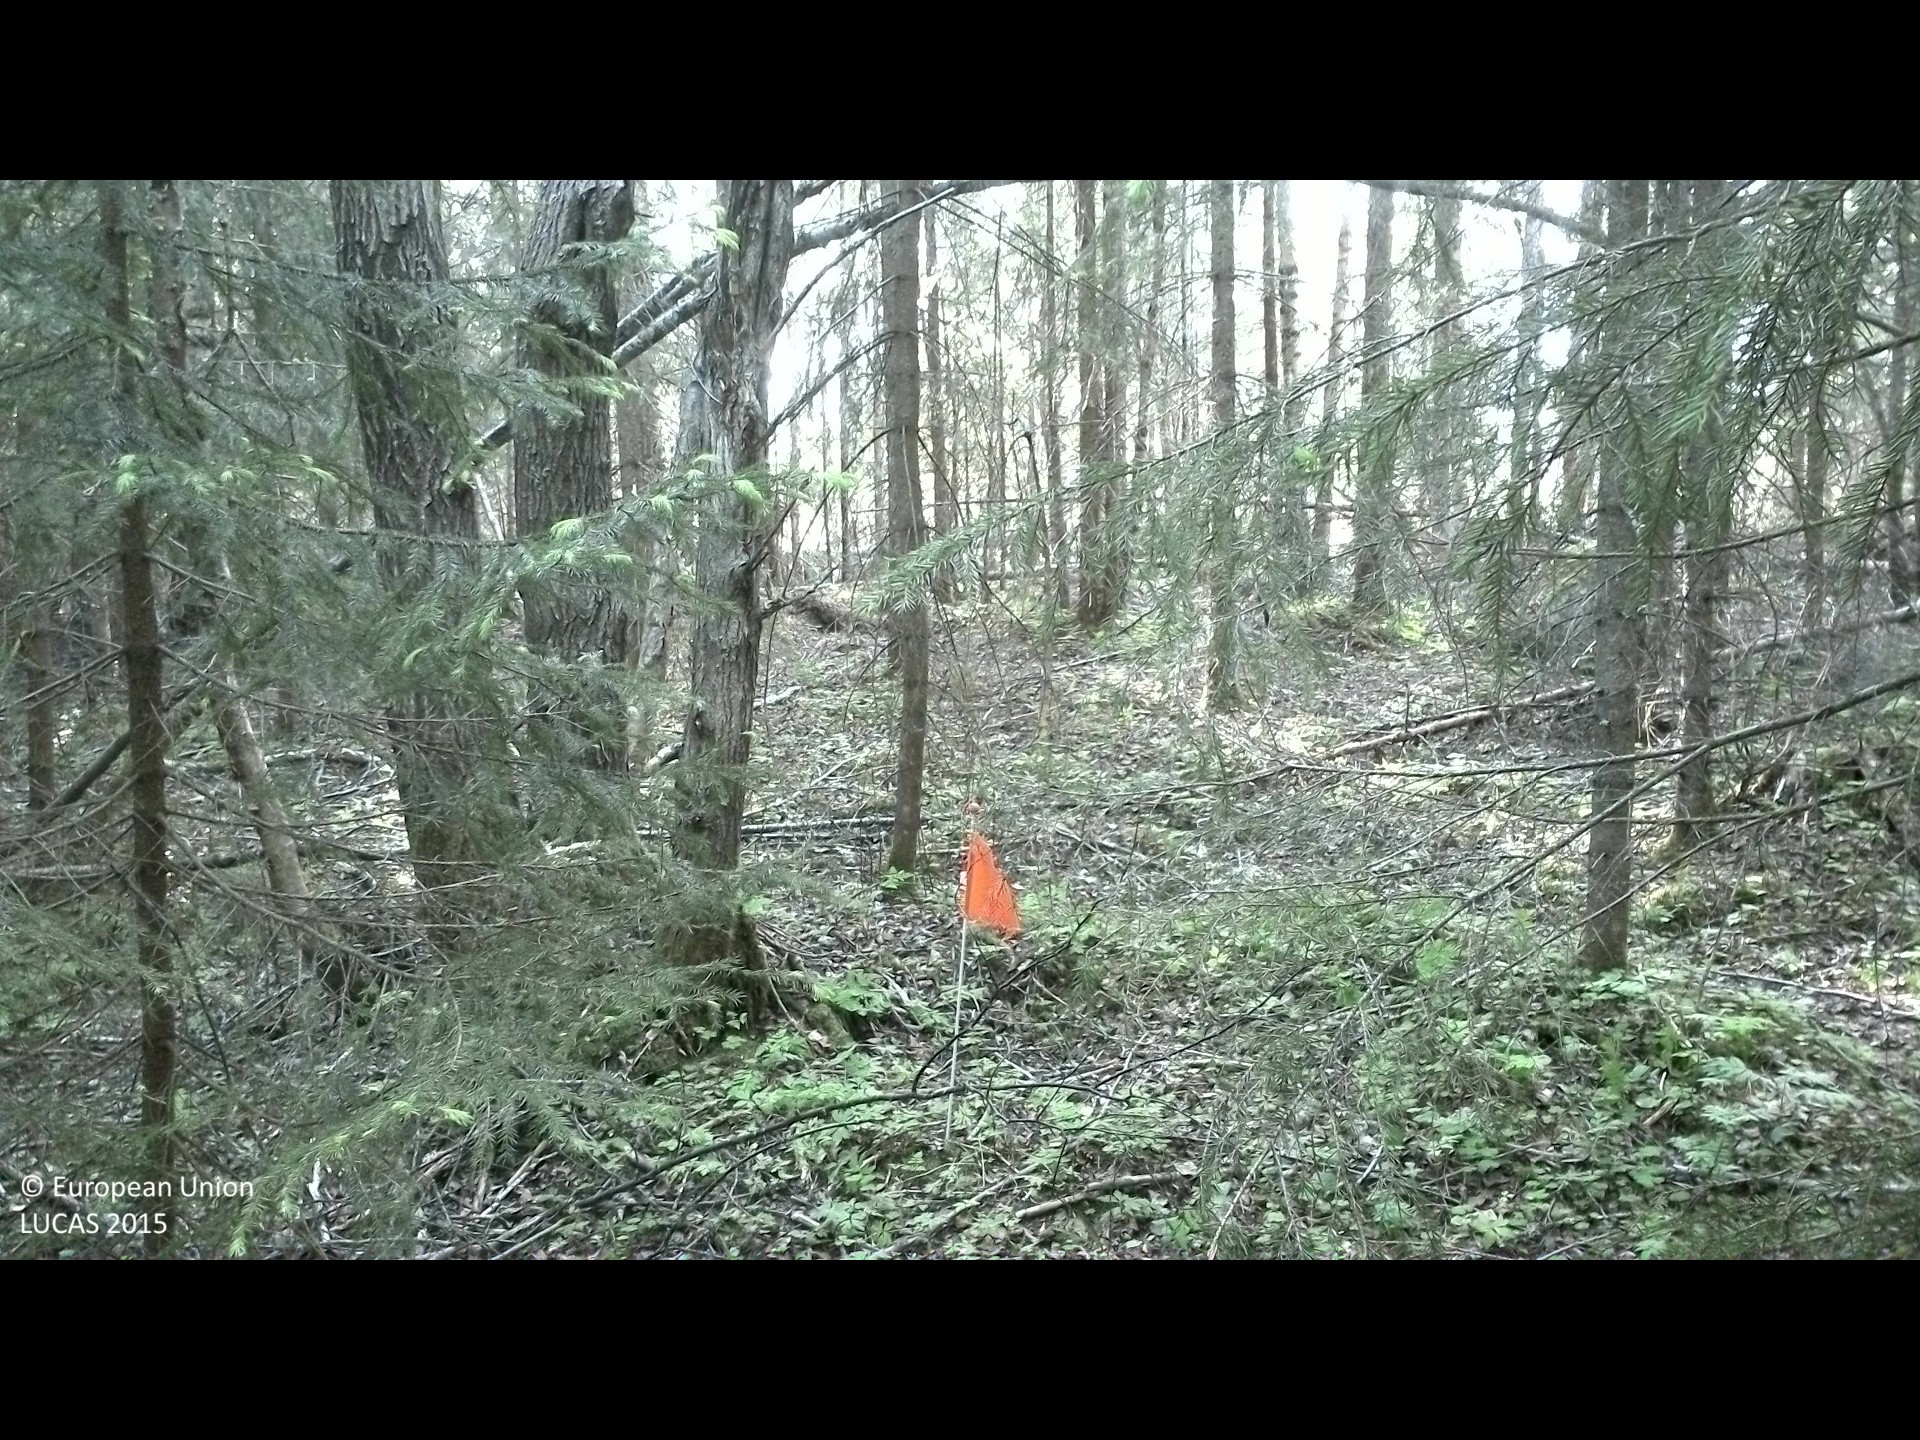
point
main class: Woodland
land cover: Spruce dominated mixed woodland
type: boreal forest
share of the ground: > 75 %
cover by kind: coniferous forest trees 45 %, broadleaved forest trees 30 %, herbaceous plants 25 %
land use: Forestry
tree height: > 5 m
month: June
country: SE
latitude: 62.2174
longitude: 17.3085
